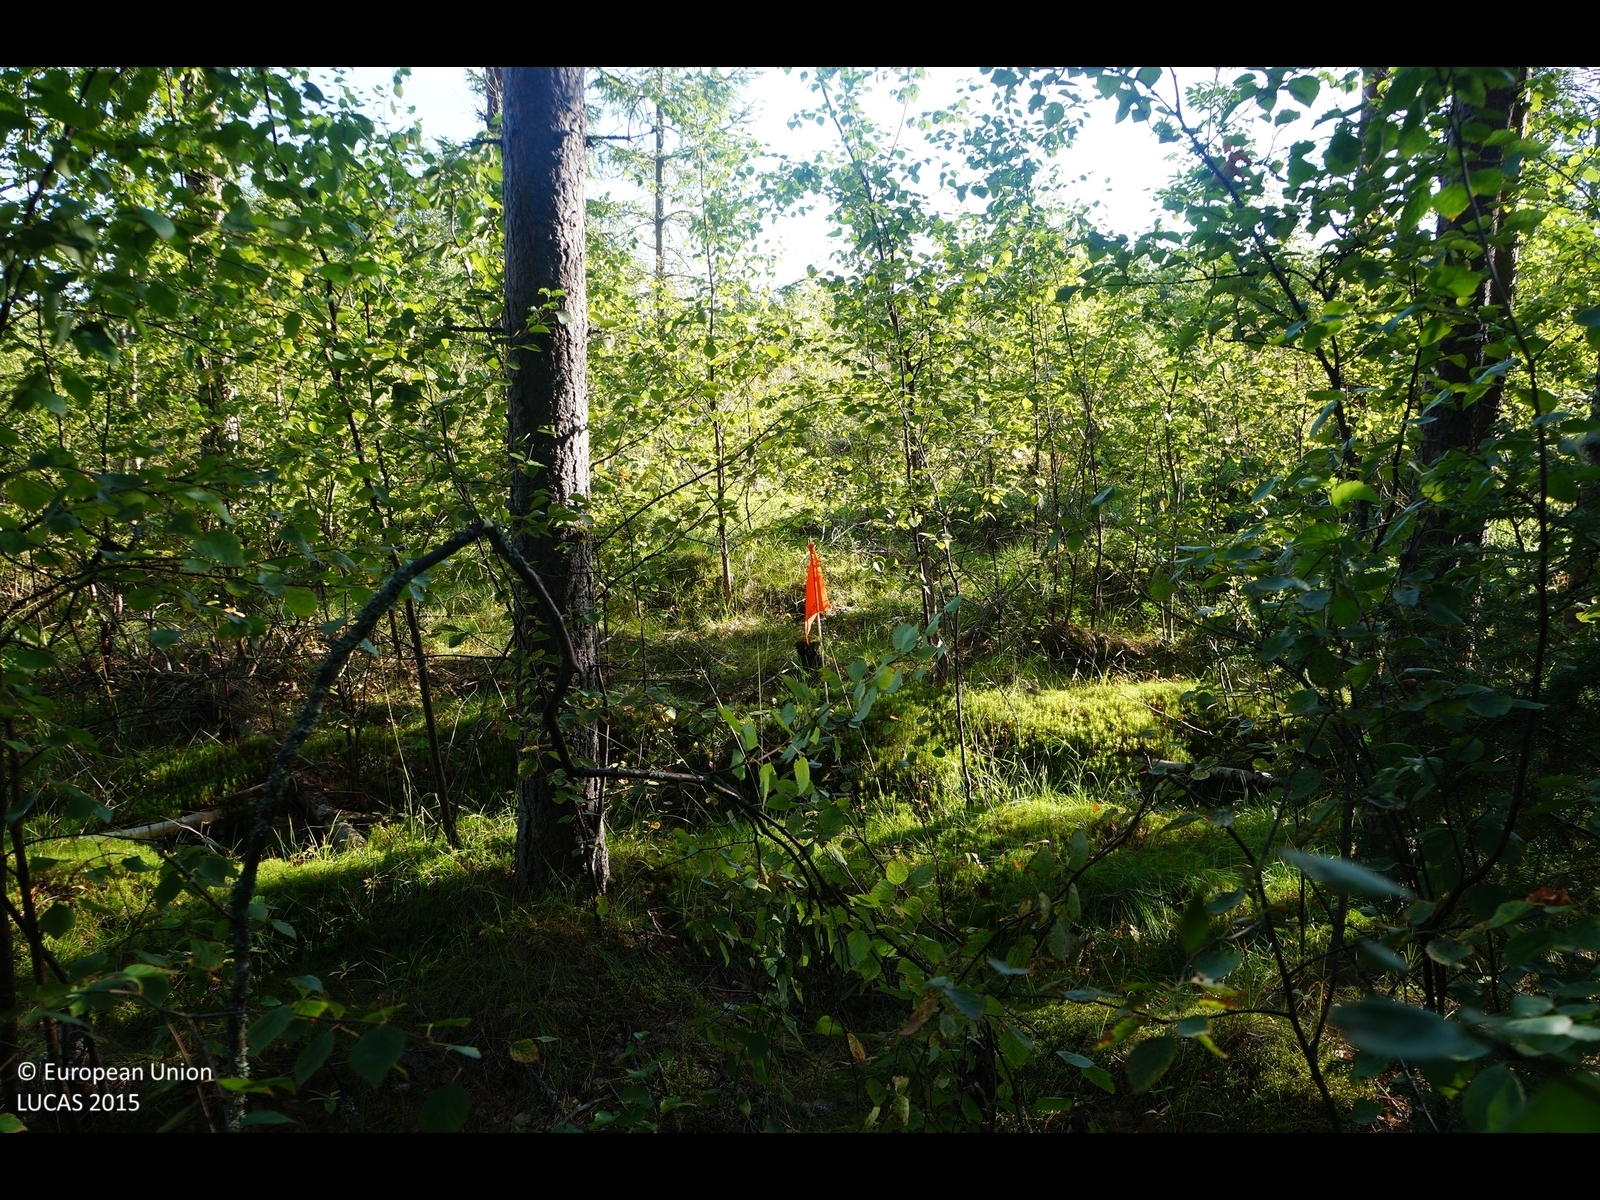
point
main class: Woodland
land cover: Pine dominated coniferous woodland
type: boreal forest
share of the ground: 50 - 75 %
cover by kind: coniferous forest trees 50 %, shrubs 35 %, lichens and mosses 10 %, herbaceous plants 5 %
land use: Forestry
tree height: > 5 m
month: August
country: FI
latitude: 64.8757
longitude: 25.0415
